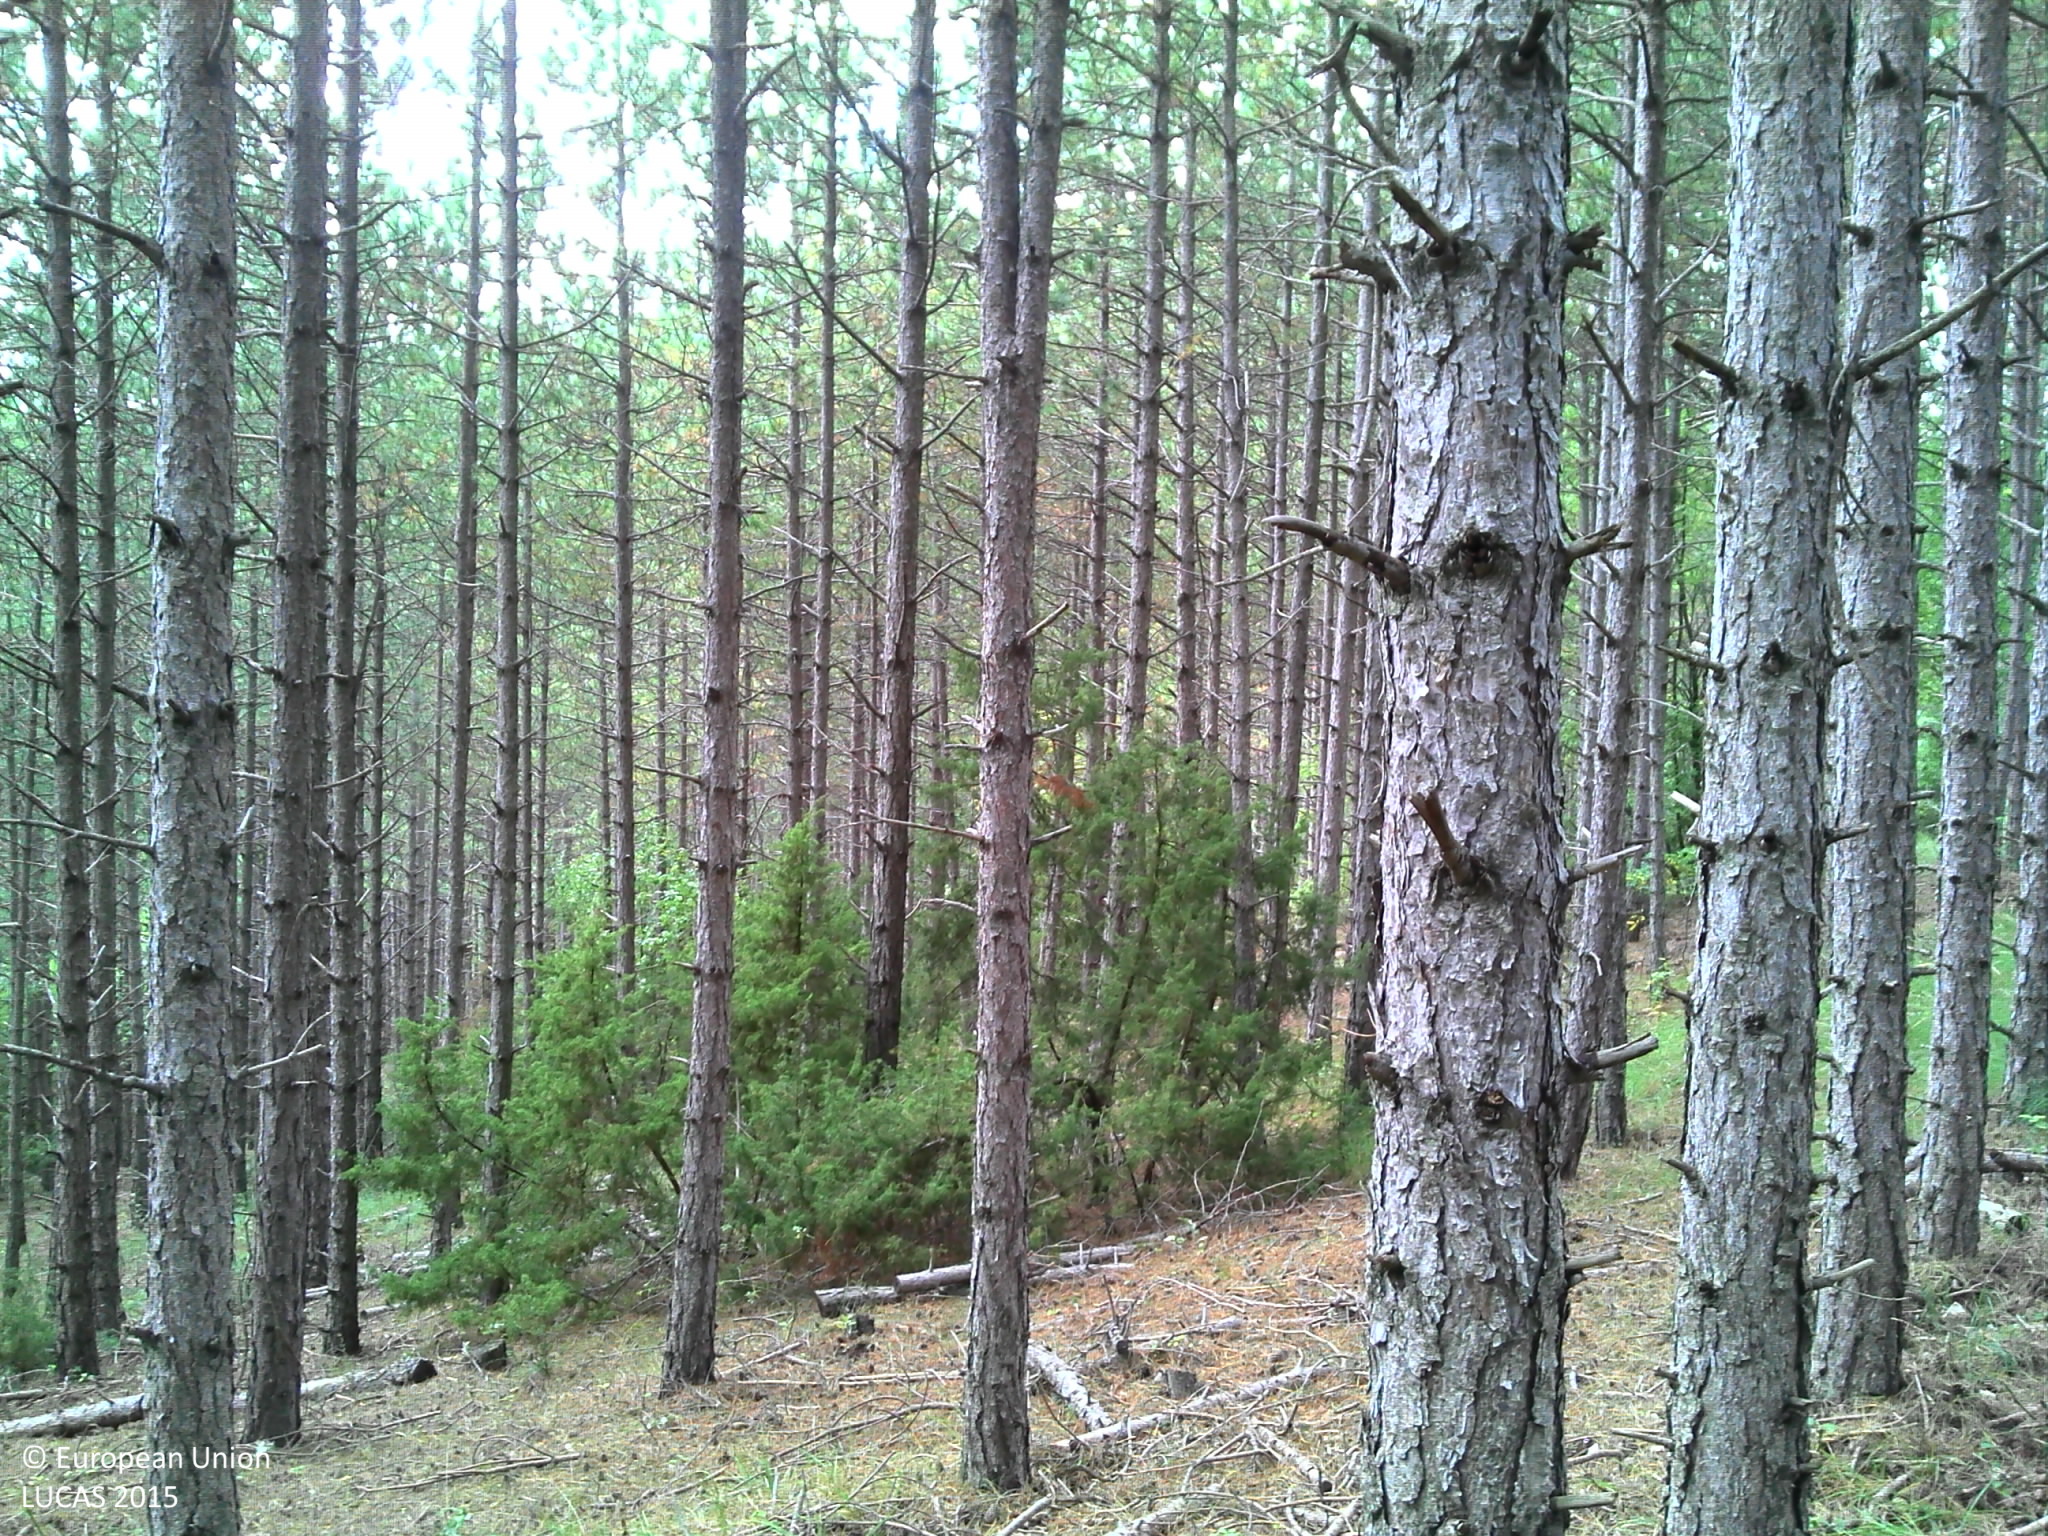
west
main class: Woodland
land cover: Pine dominated coniferous woodland
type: exotic forest
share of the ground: > 75 %
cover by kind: coniferous forest trees 80 %, herbaceous plants 15 %, shrubs 5 %
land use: Forestry
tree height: > 5 m
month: September
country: FR
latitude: 44.4716
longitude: 5.5444
